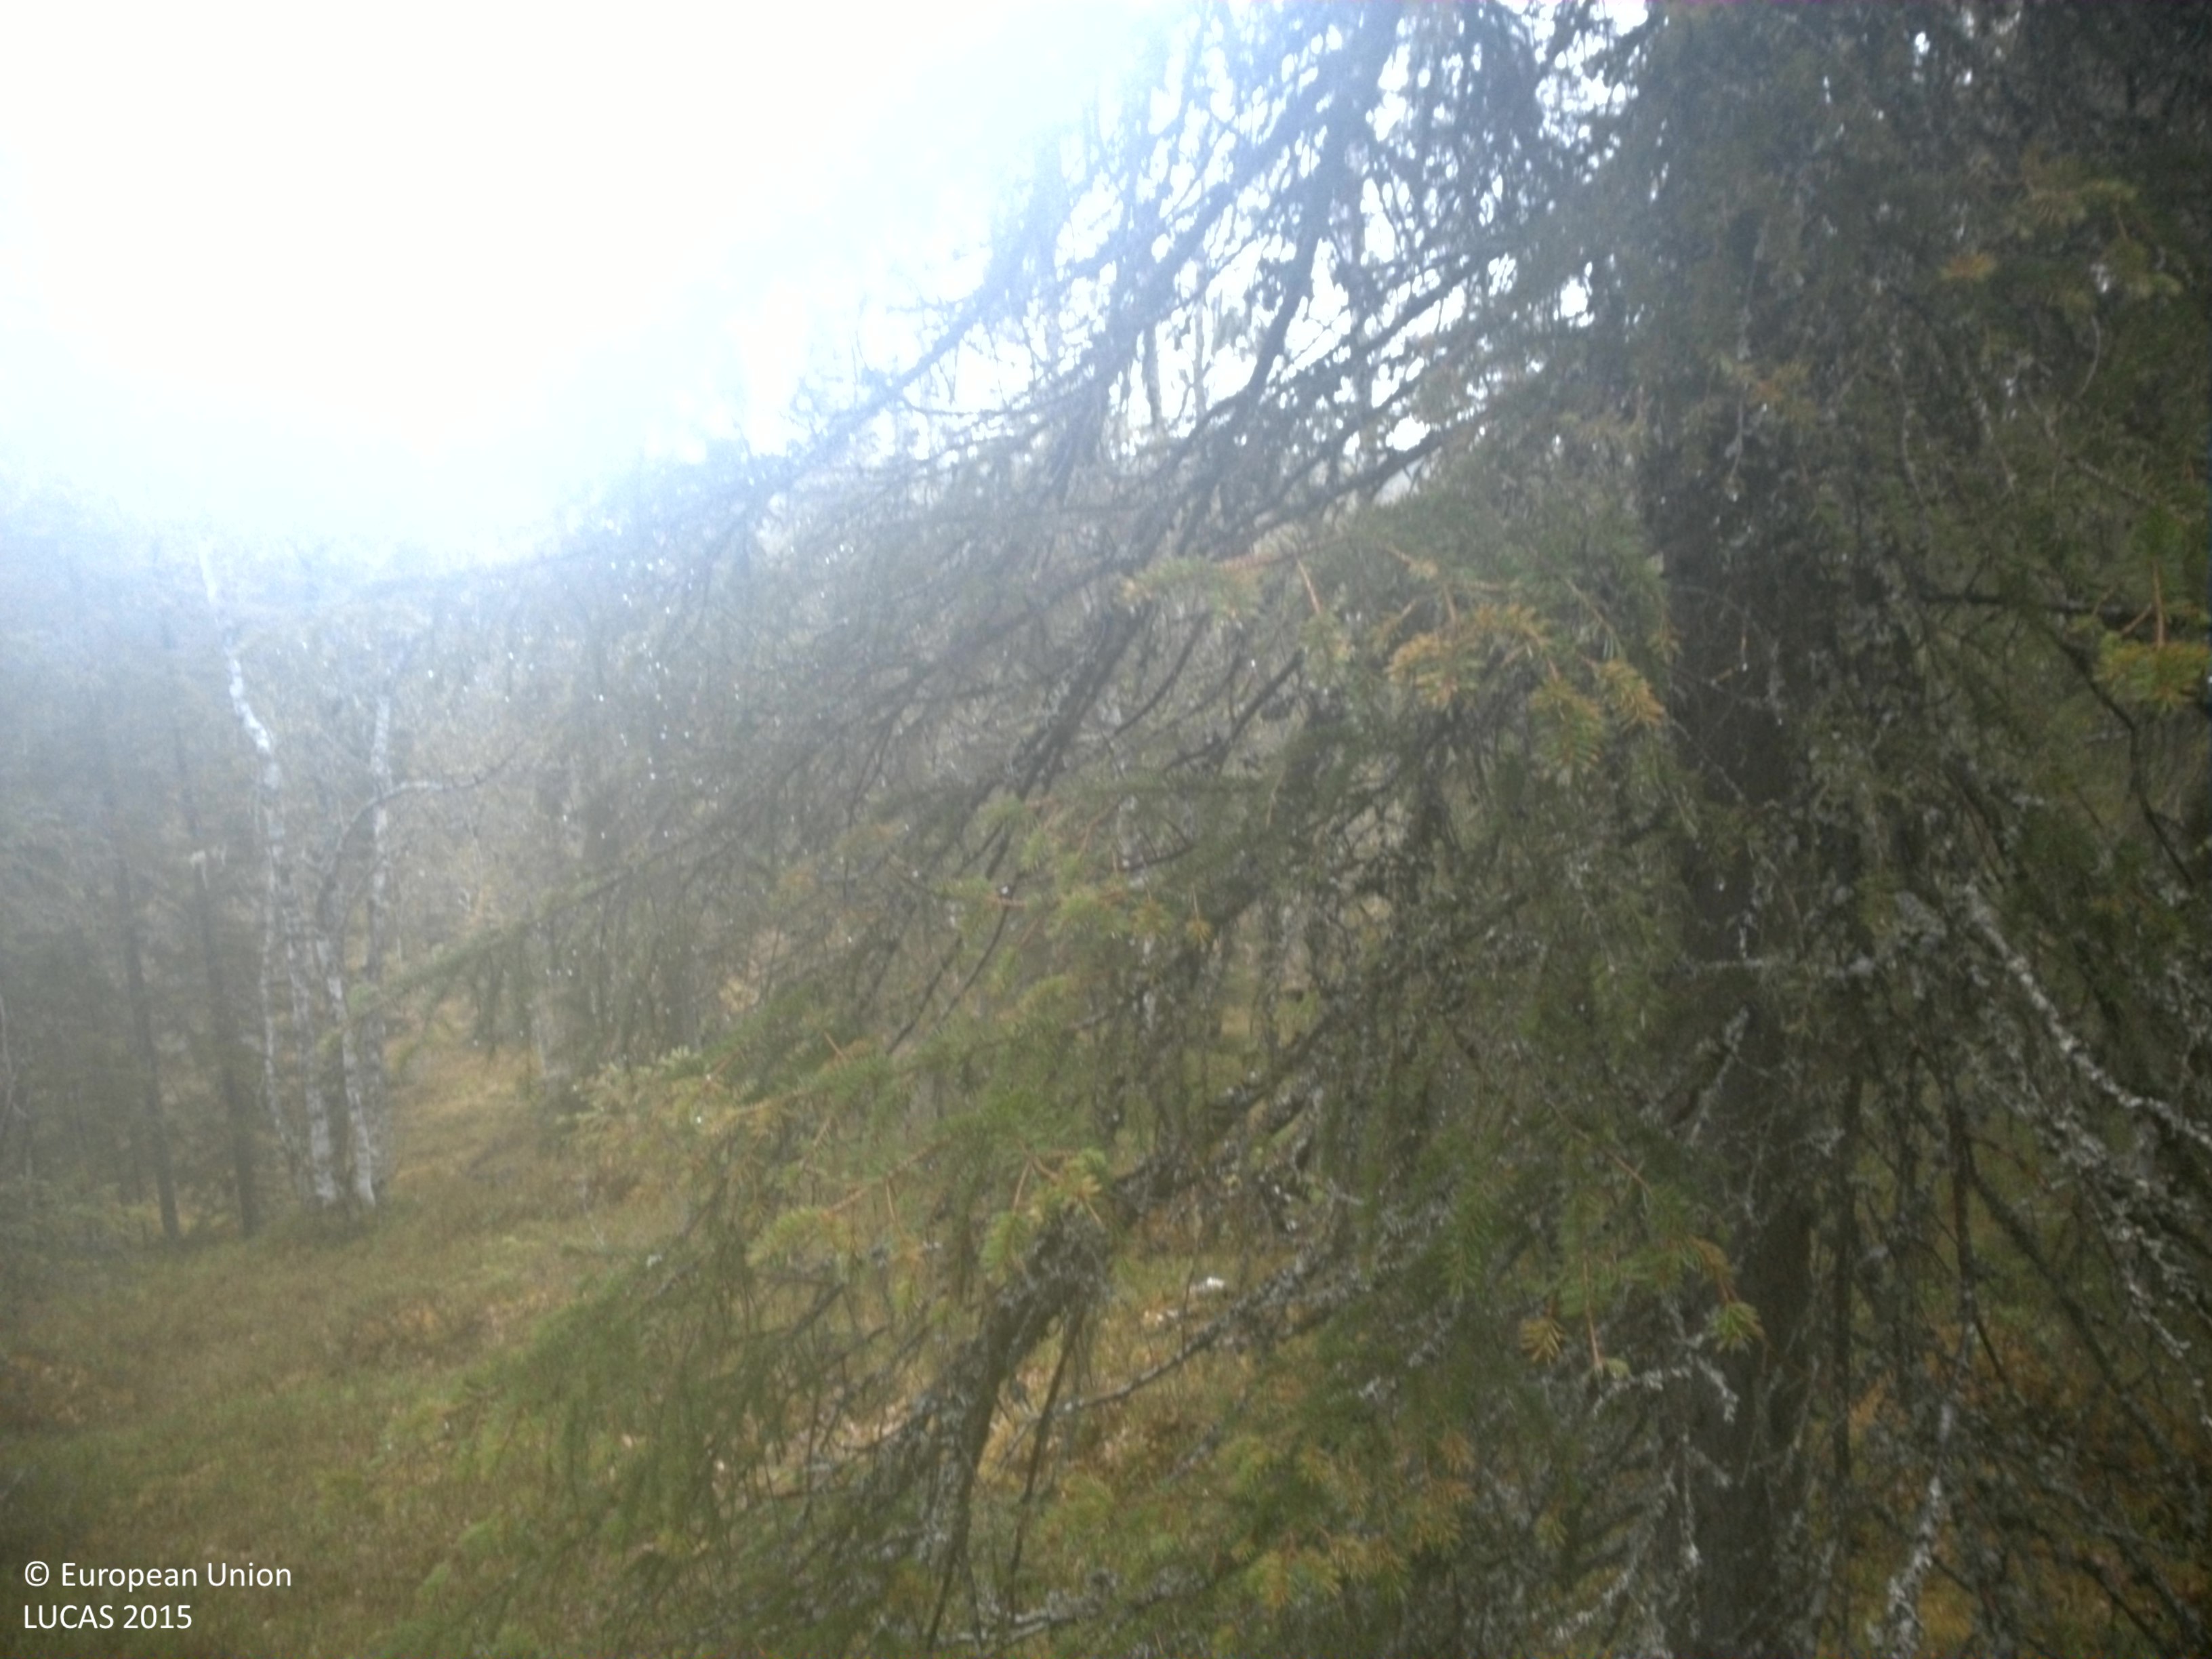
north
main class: Woodland
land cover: Spruce dominated coniferous woodland
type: boreal forest
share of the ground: 50 - 75 %
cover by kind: coniferous forest trees 50 %, herbaceous plants 20 %, lichens and mosses 15 %, broadleaved forest trees 10 %, shrubs 5 %
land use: Forestry
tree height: > 5 m
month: June
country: SE
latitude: 64.3722
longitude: 18.1123
